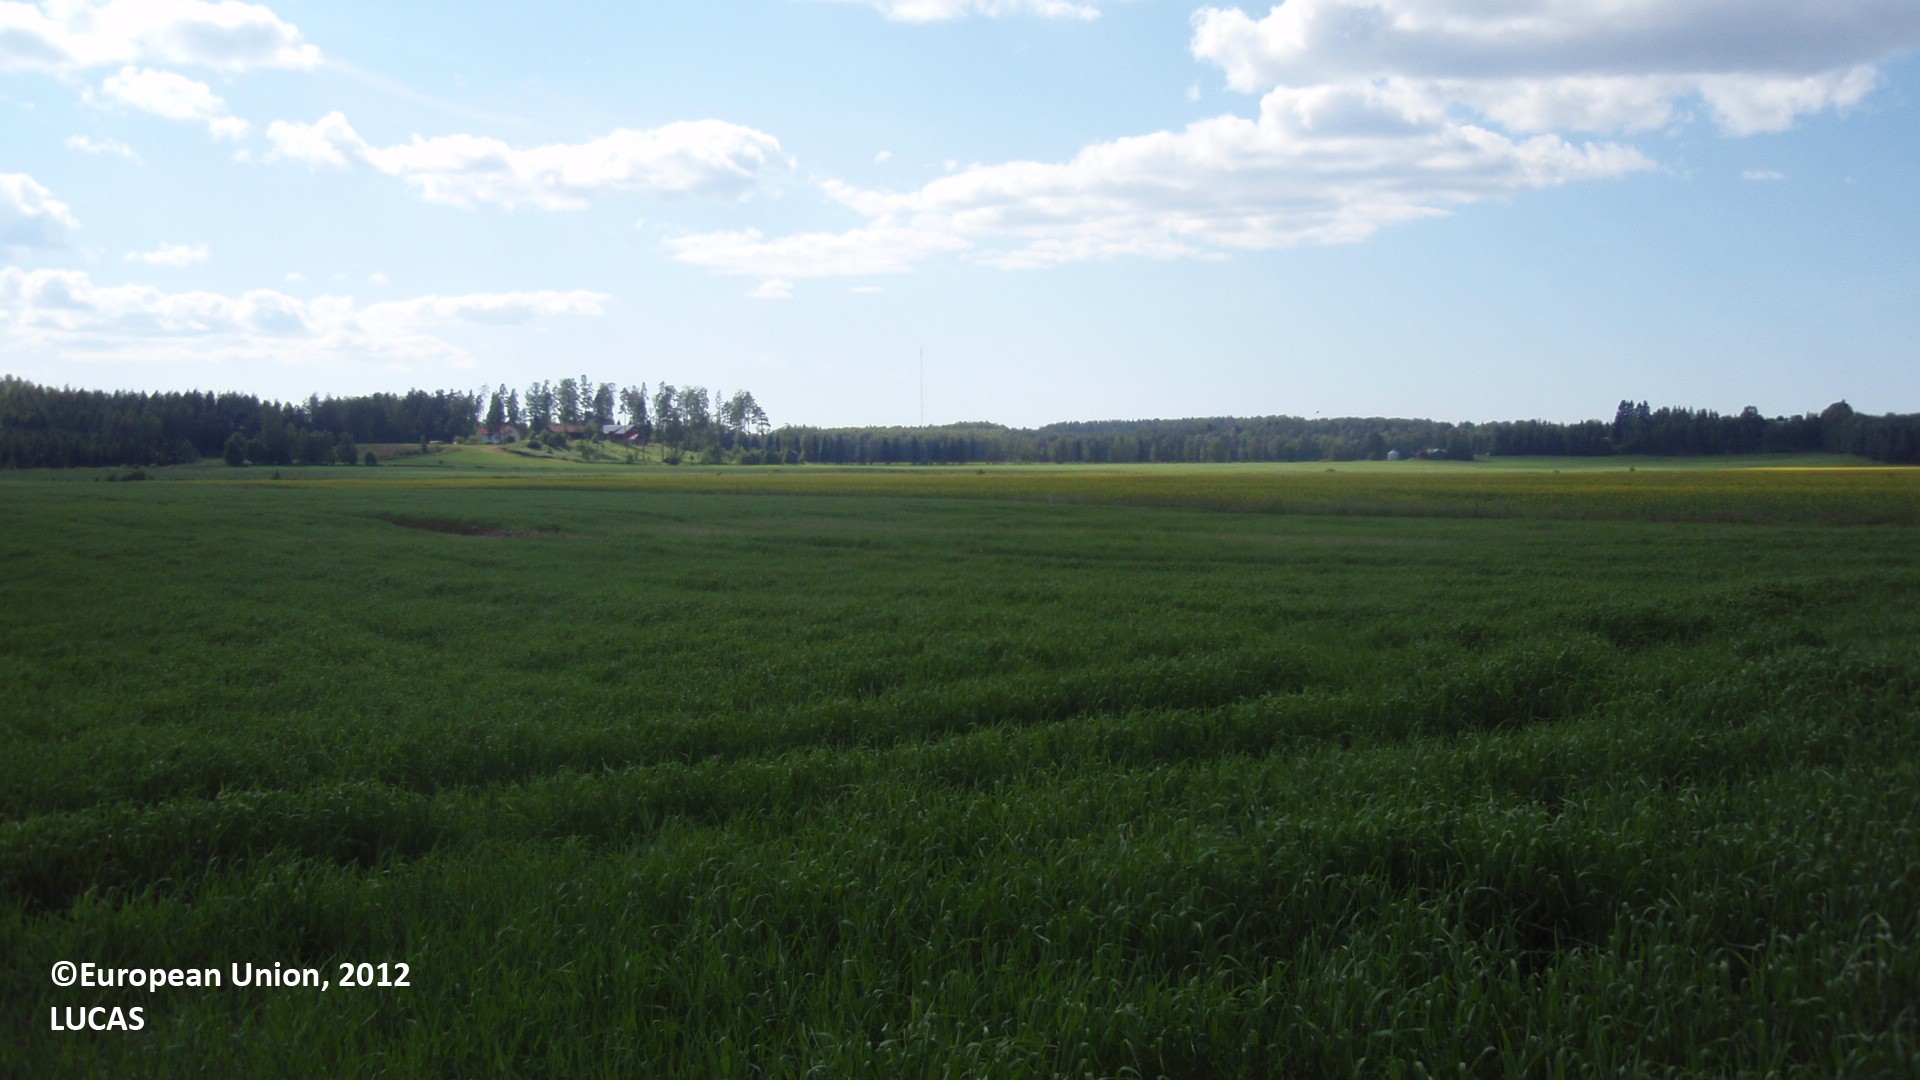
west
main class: Cropland
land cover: Barley
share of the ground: > 75 %
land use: Agriculture (excluding fallow land and kitchen gardens)
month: July
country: FI
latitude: 61.5208
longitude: 29.6381
